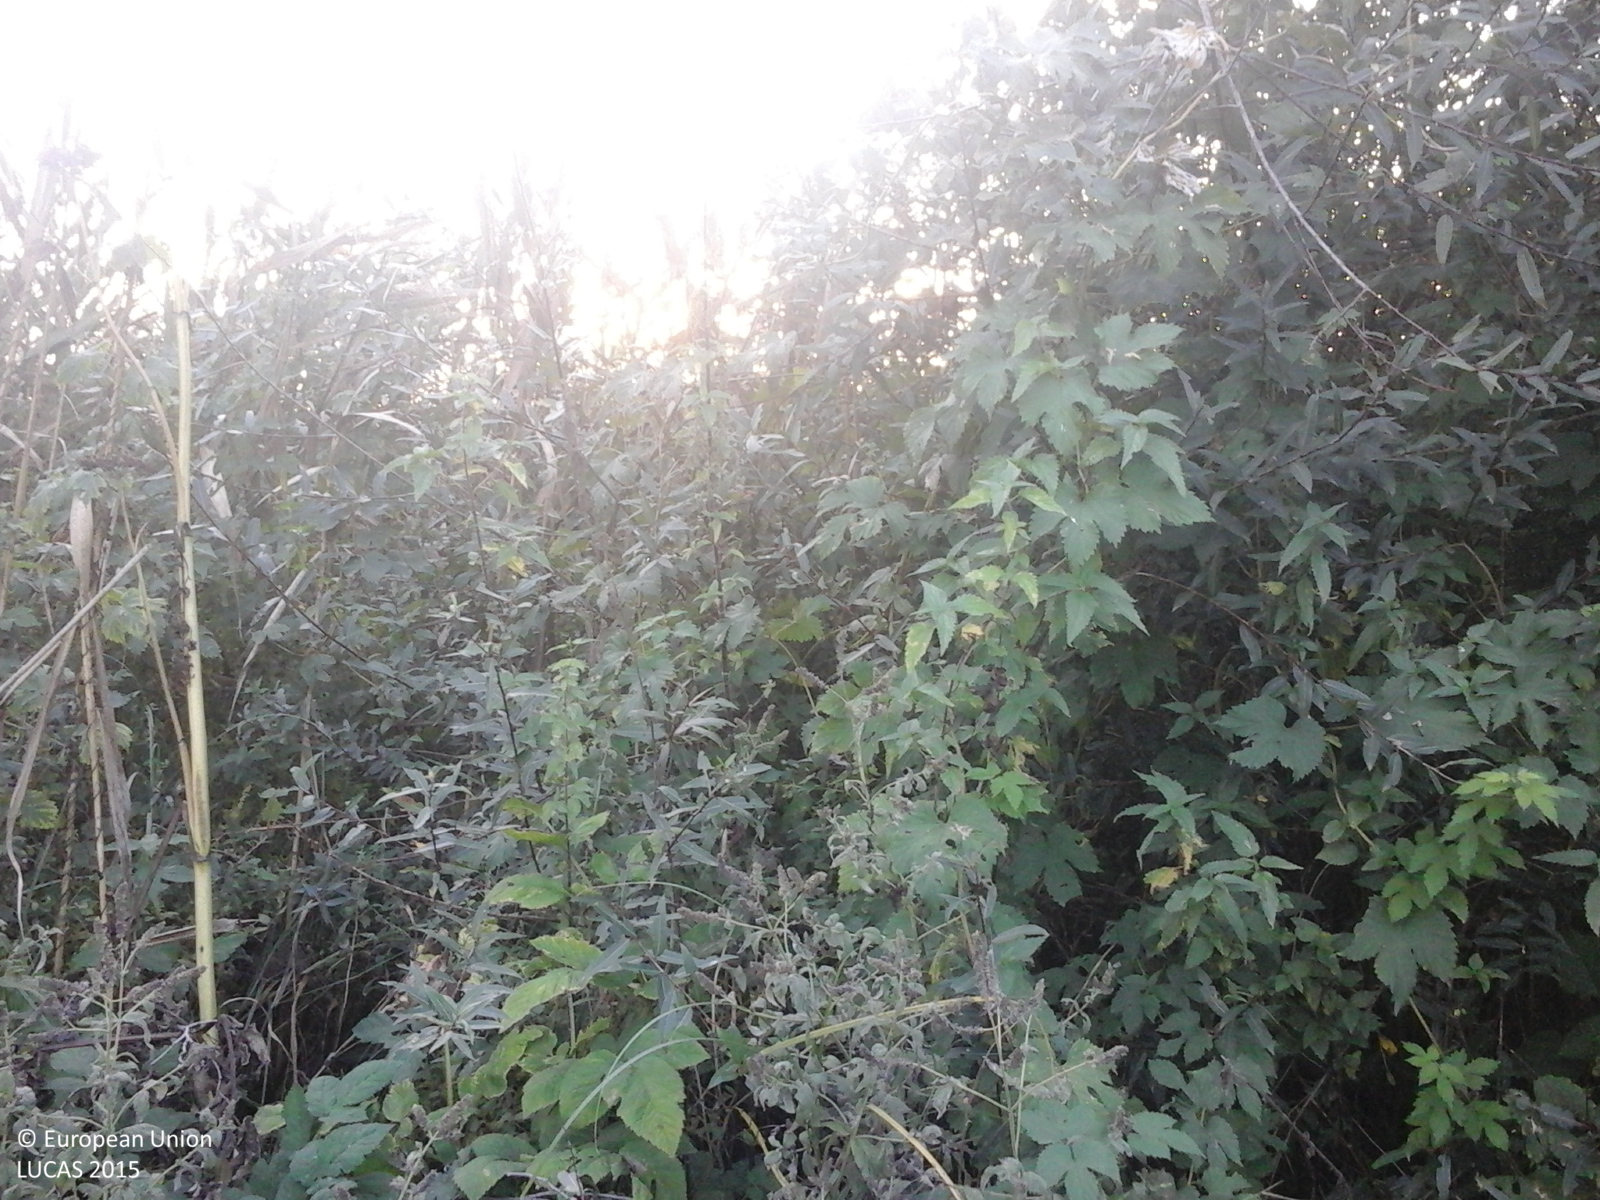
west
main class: Shrubland
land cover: Shrubland with sparse tree cover
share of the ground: > 75 %
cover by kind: shrubs 95 %, broadleaved forest trees 5 %
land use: Semi-natural and natural areas not in use
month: September
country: RO
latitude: 45.1626
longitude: 22.3172
